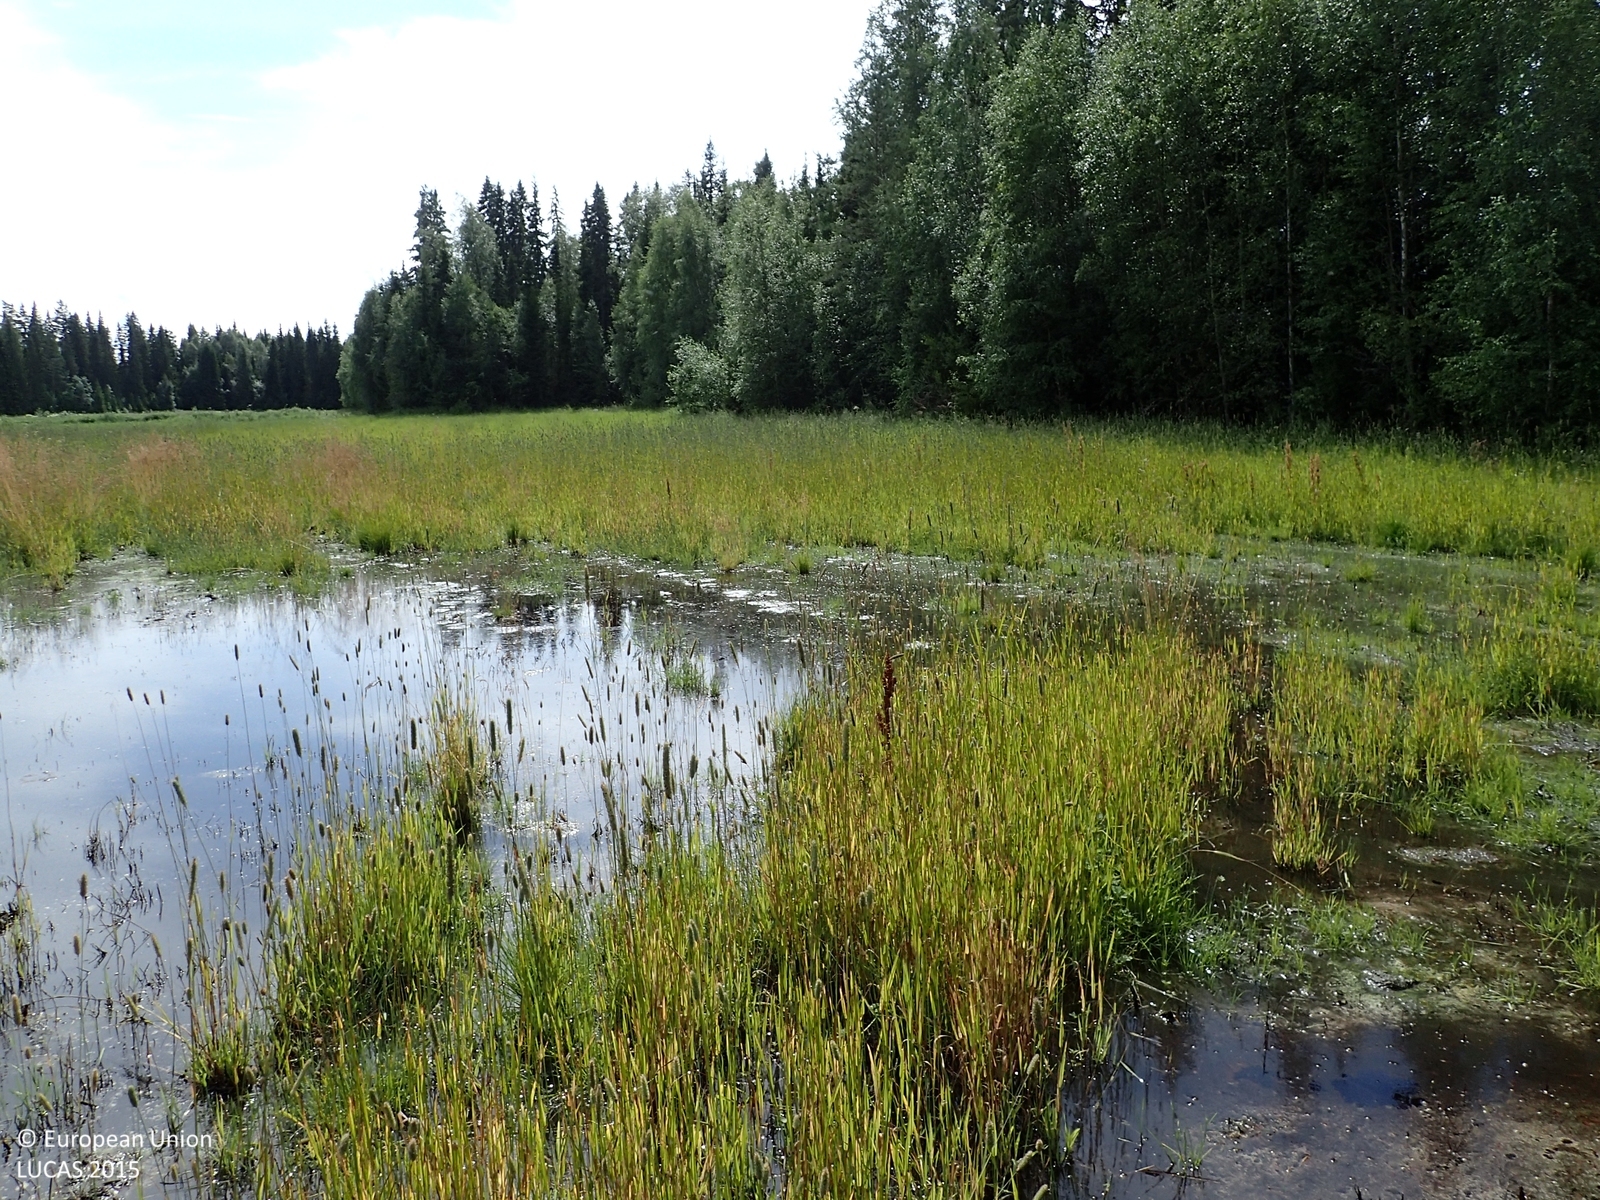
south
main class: Grassland
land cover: Spontaneously vegetated surfaces
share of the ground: > 75 %
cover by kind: herbaceous plants 100 %
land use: Fallow land
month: August
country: FI
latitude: 62.8374
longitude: 21.8451
